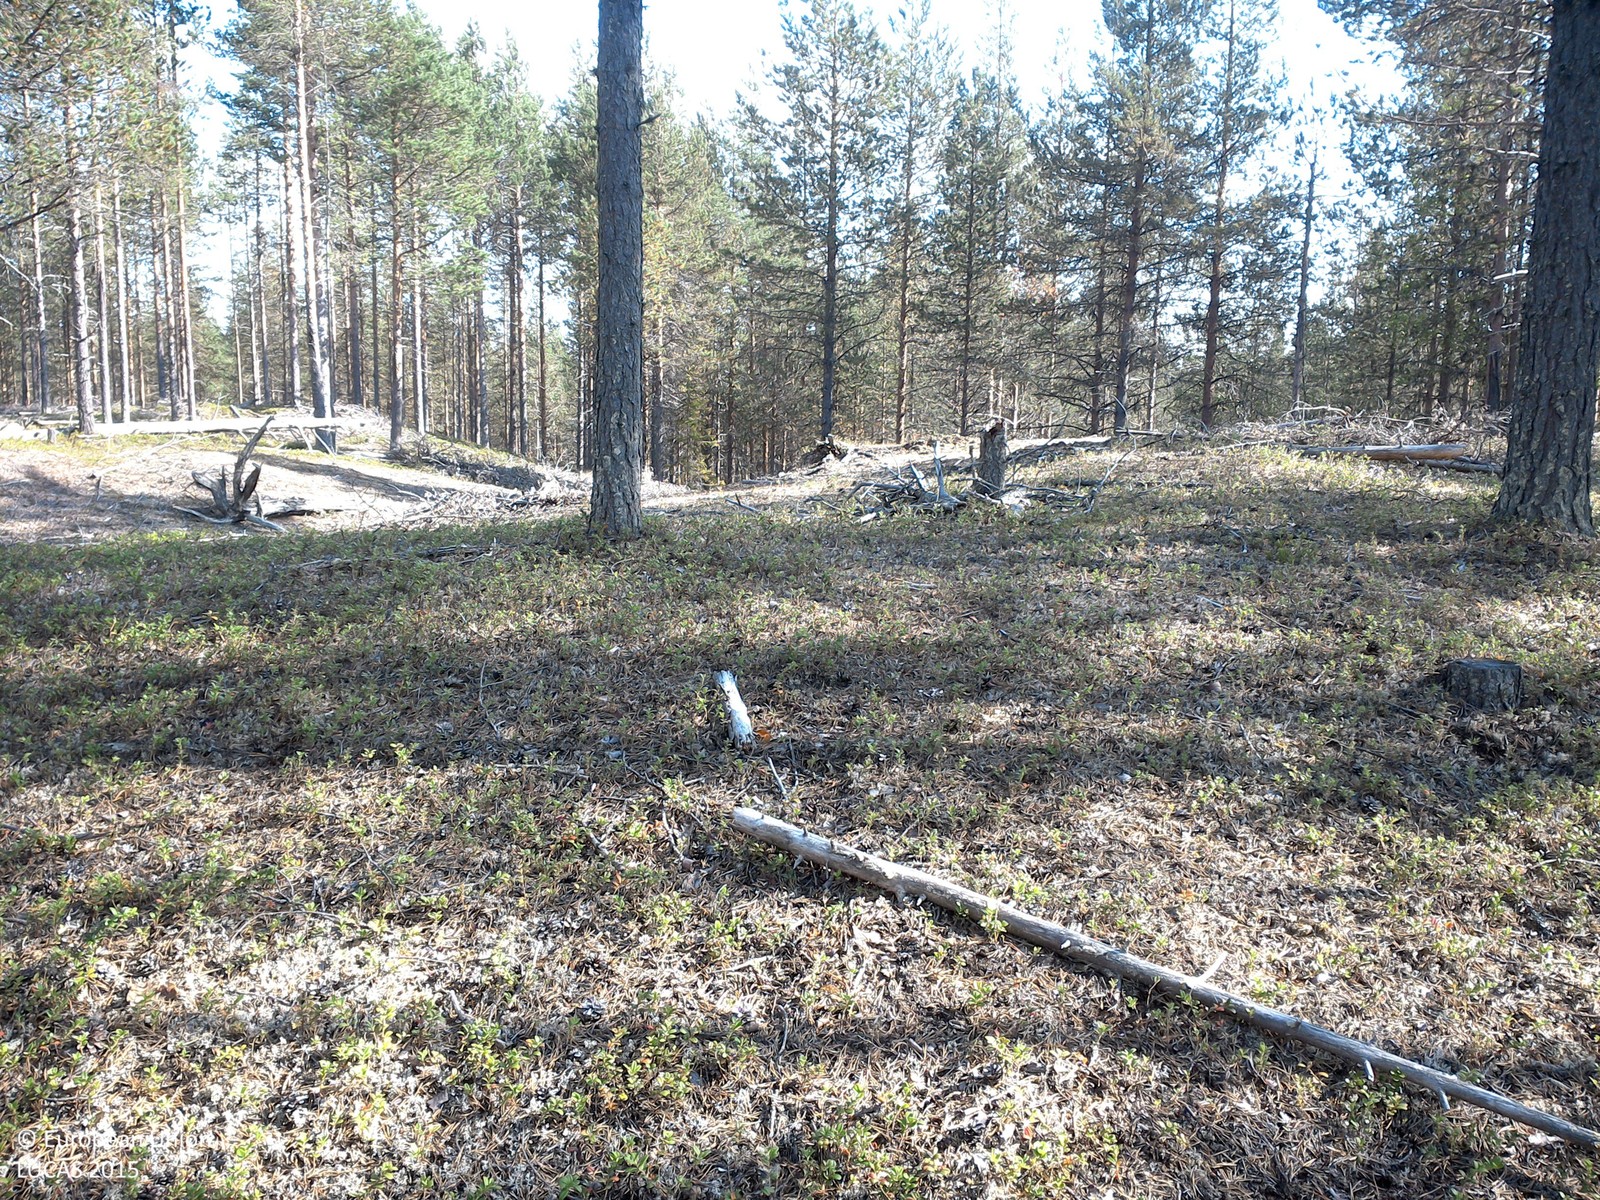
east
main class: Woodland
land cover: Pine dominated coniferous woodland
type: boreal forest
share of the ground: 25 - 50 %
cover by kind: lichens and mosses 45 %, coniferous forest trees 30 %, shrubs 25 %
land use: Forestry
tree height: > 5 m
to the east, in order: Pine dominated coniferous woodland; Tracks; Pine dominated coniferous woodland; Tracks; Pine dominated coniferous woodland; Tracks; Pine dominated coniferous woodland; Tracks; Pine dominated coniferous woodland; Tracks; Pine dominated coniferous woodland; Electric lines; Pine dominated mixed woodland
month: August
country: SE
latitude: 67.3765
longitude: 22.1867
